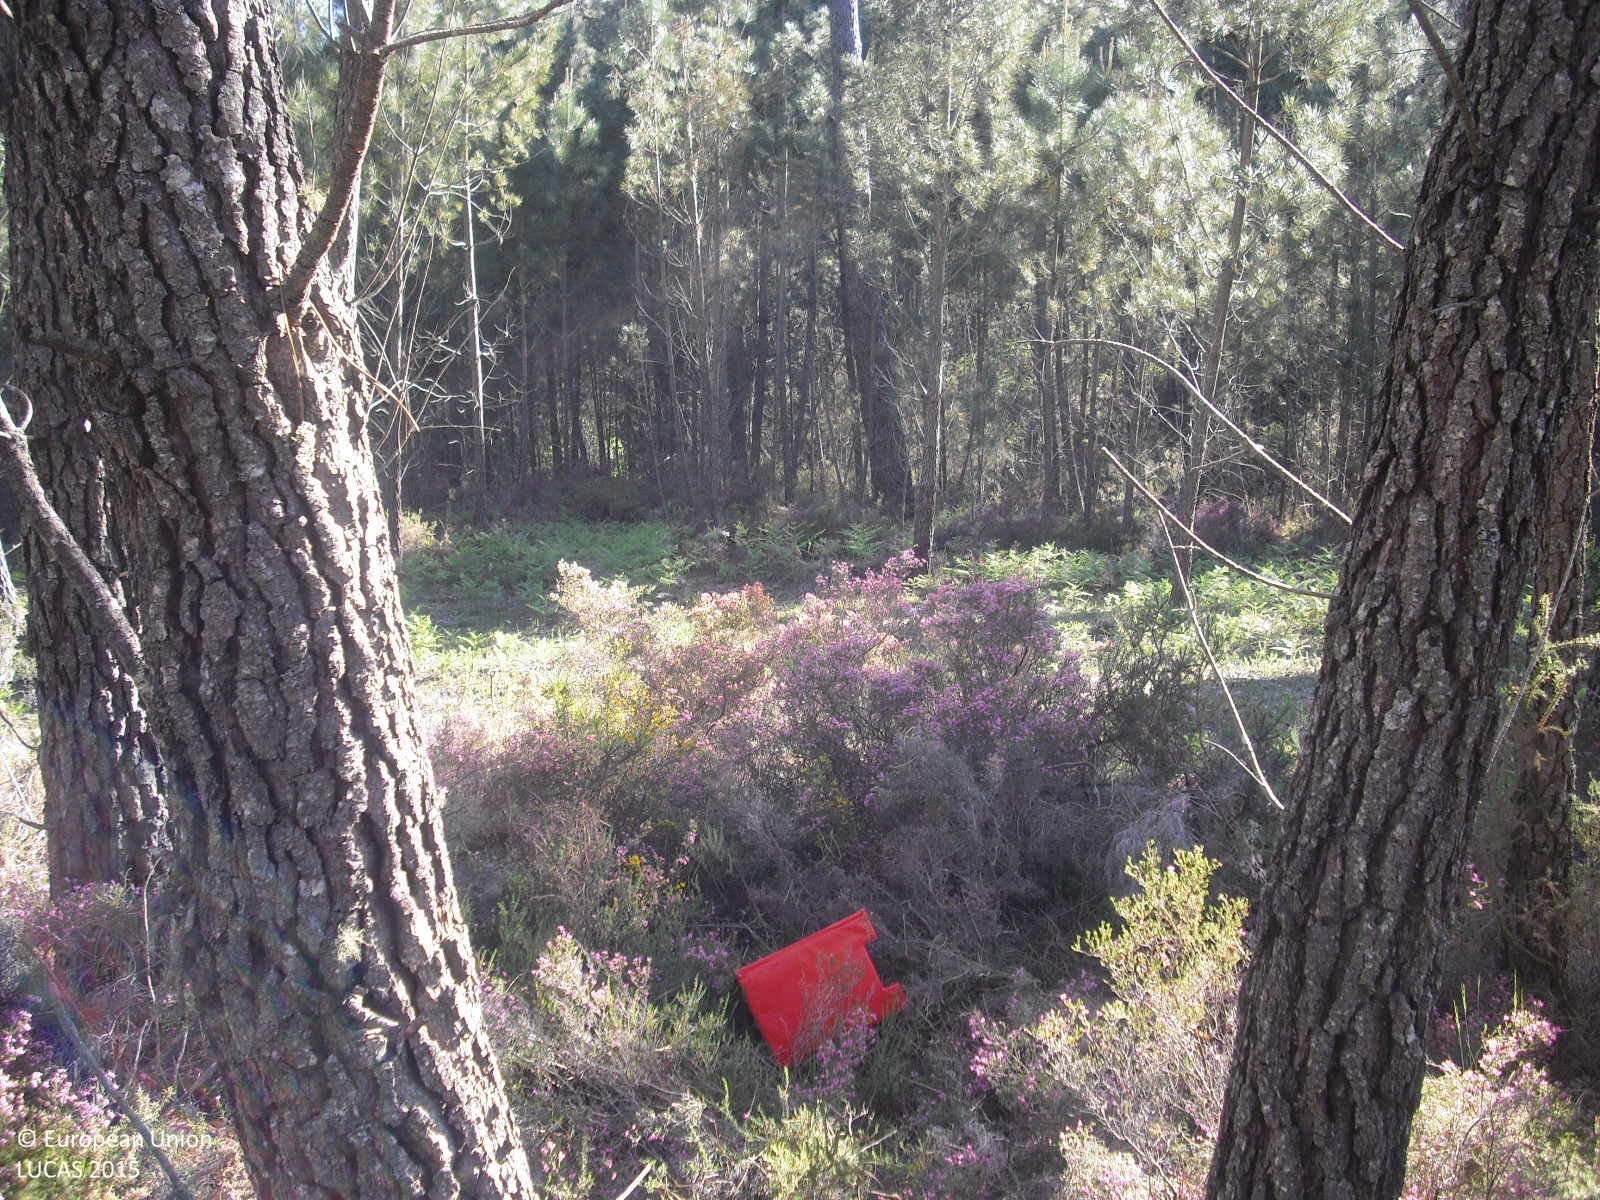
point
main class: Woodland
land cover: Pine dominated coniferous woodland
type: exotic forest
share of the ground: 25 - 50 %
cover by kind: shrubs 60 %, coniferous forest trees 40 %
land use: Forestry
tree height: > 5 m
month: May
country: ES
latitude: 41.9204
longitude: -8.1541
